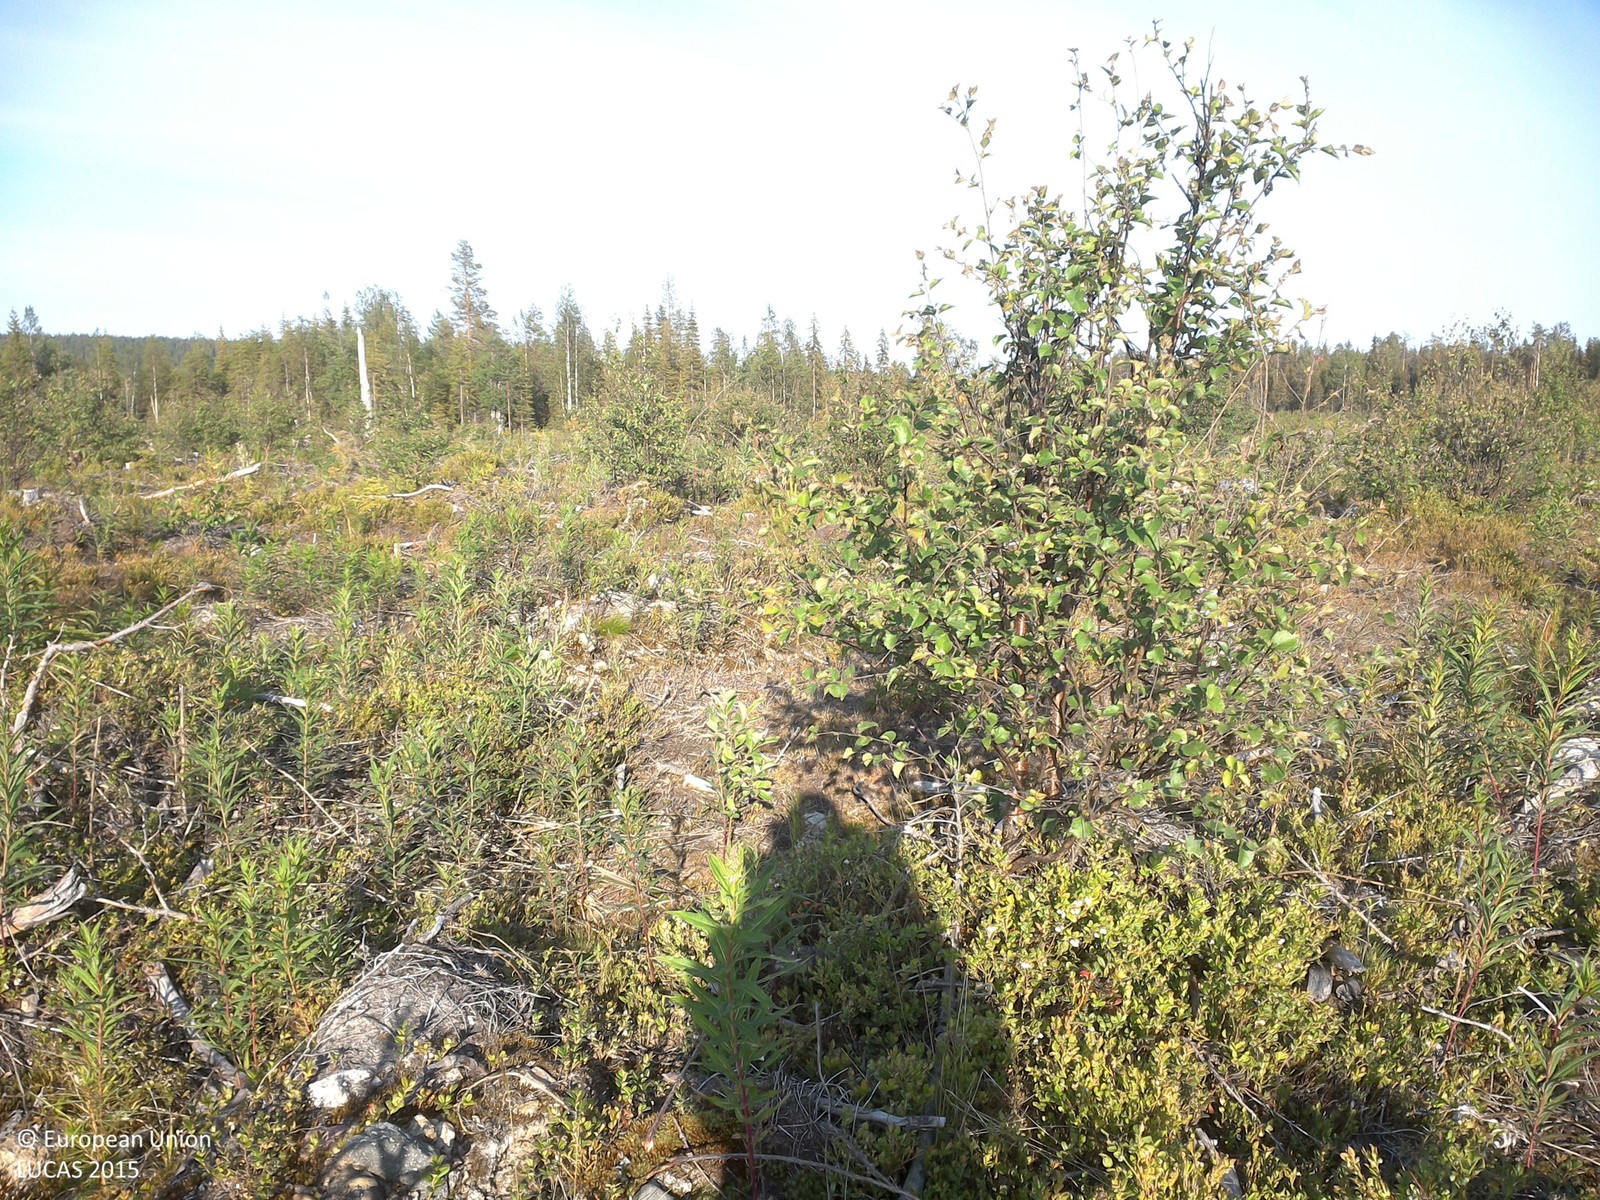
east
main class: Woodland
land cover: Broadleaved woodland
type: boreal forest
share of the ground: 10 - 25 %
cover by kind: shrubs 70 %, broadleaved forest trees 15 %, unconsolidated bare surface 10 %, lichens and mosses 5 %
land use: Forestry
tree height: < 5 m
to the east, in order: Broadleaved woodland; Spruce dominated mixed woodland; Pine dominated mixed woodland; Other mixed woodland
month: July
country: SE
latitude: 67.1293
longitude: 22.8092
